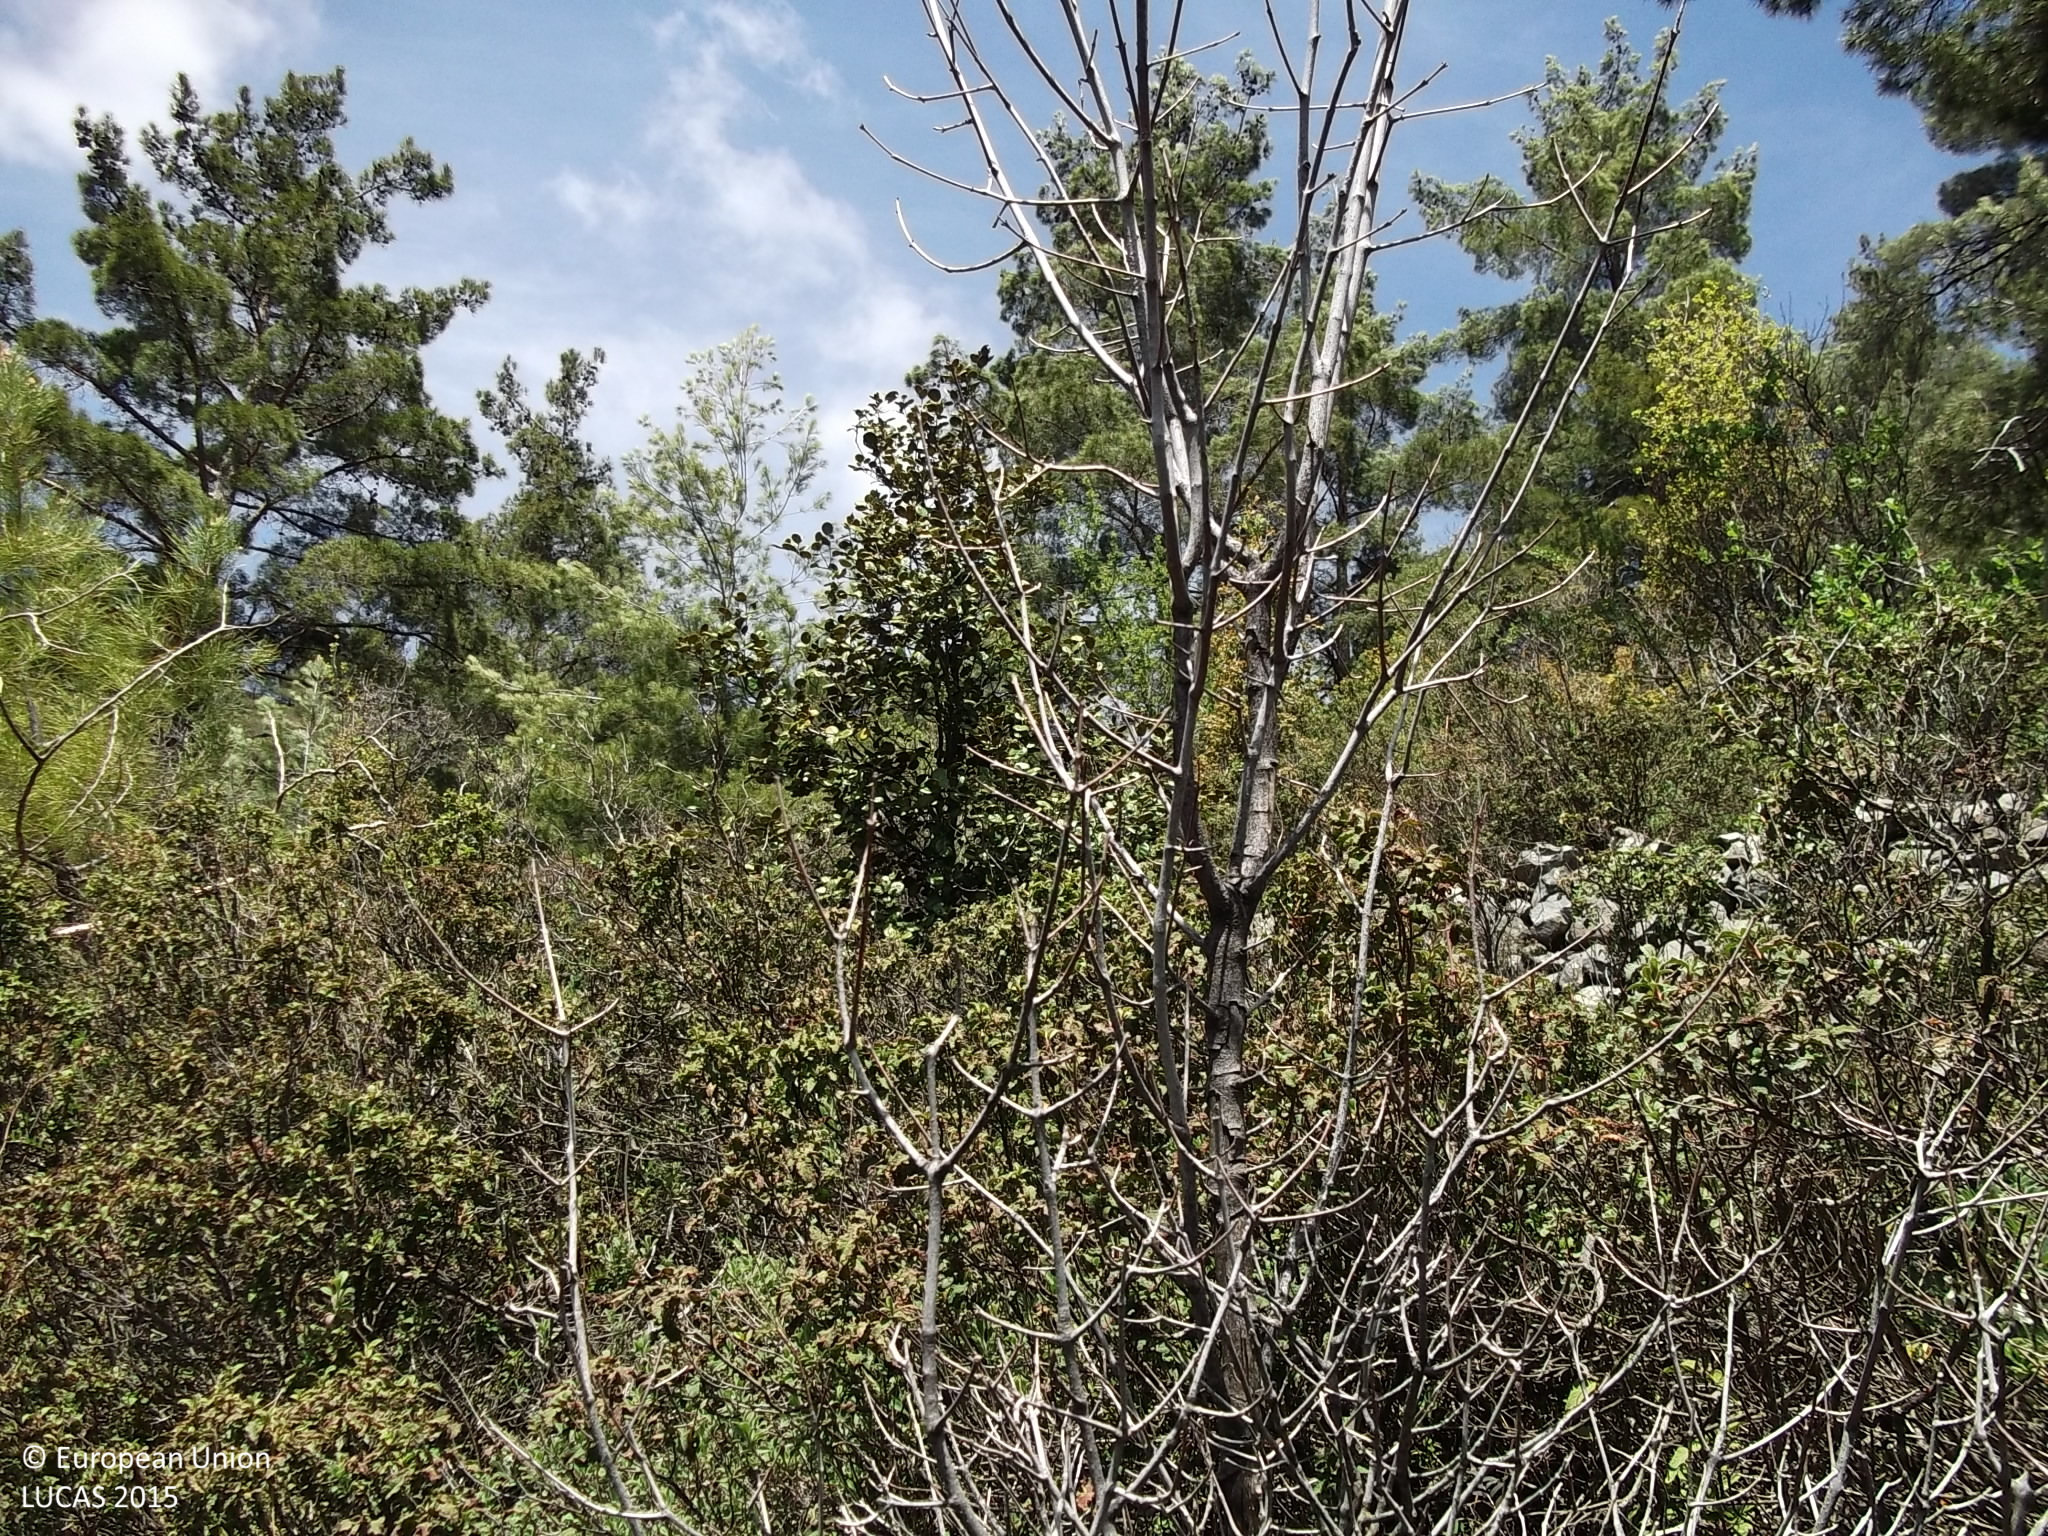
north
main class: Woodland
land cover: Pine dominated mixed woodland
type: coniferous forest of the mediterranean region
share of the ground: 25 - 50 %
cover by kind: shrubs 40 %, coniferous forest trees 35 %, broadleaved forest trees 15 %, consolidated bare surface 5 %, unconsolidated bare surface 5 %
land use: Semi-natural and natural areas not in use
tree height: > 5 m
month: April
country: CY
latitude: 34.9124
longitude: 33.1962
